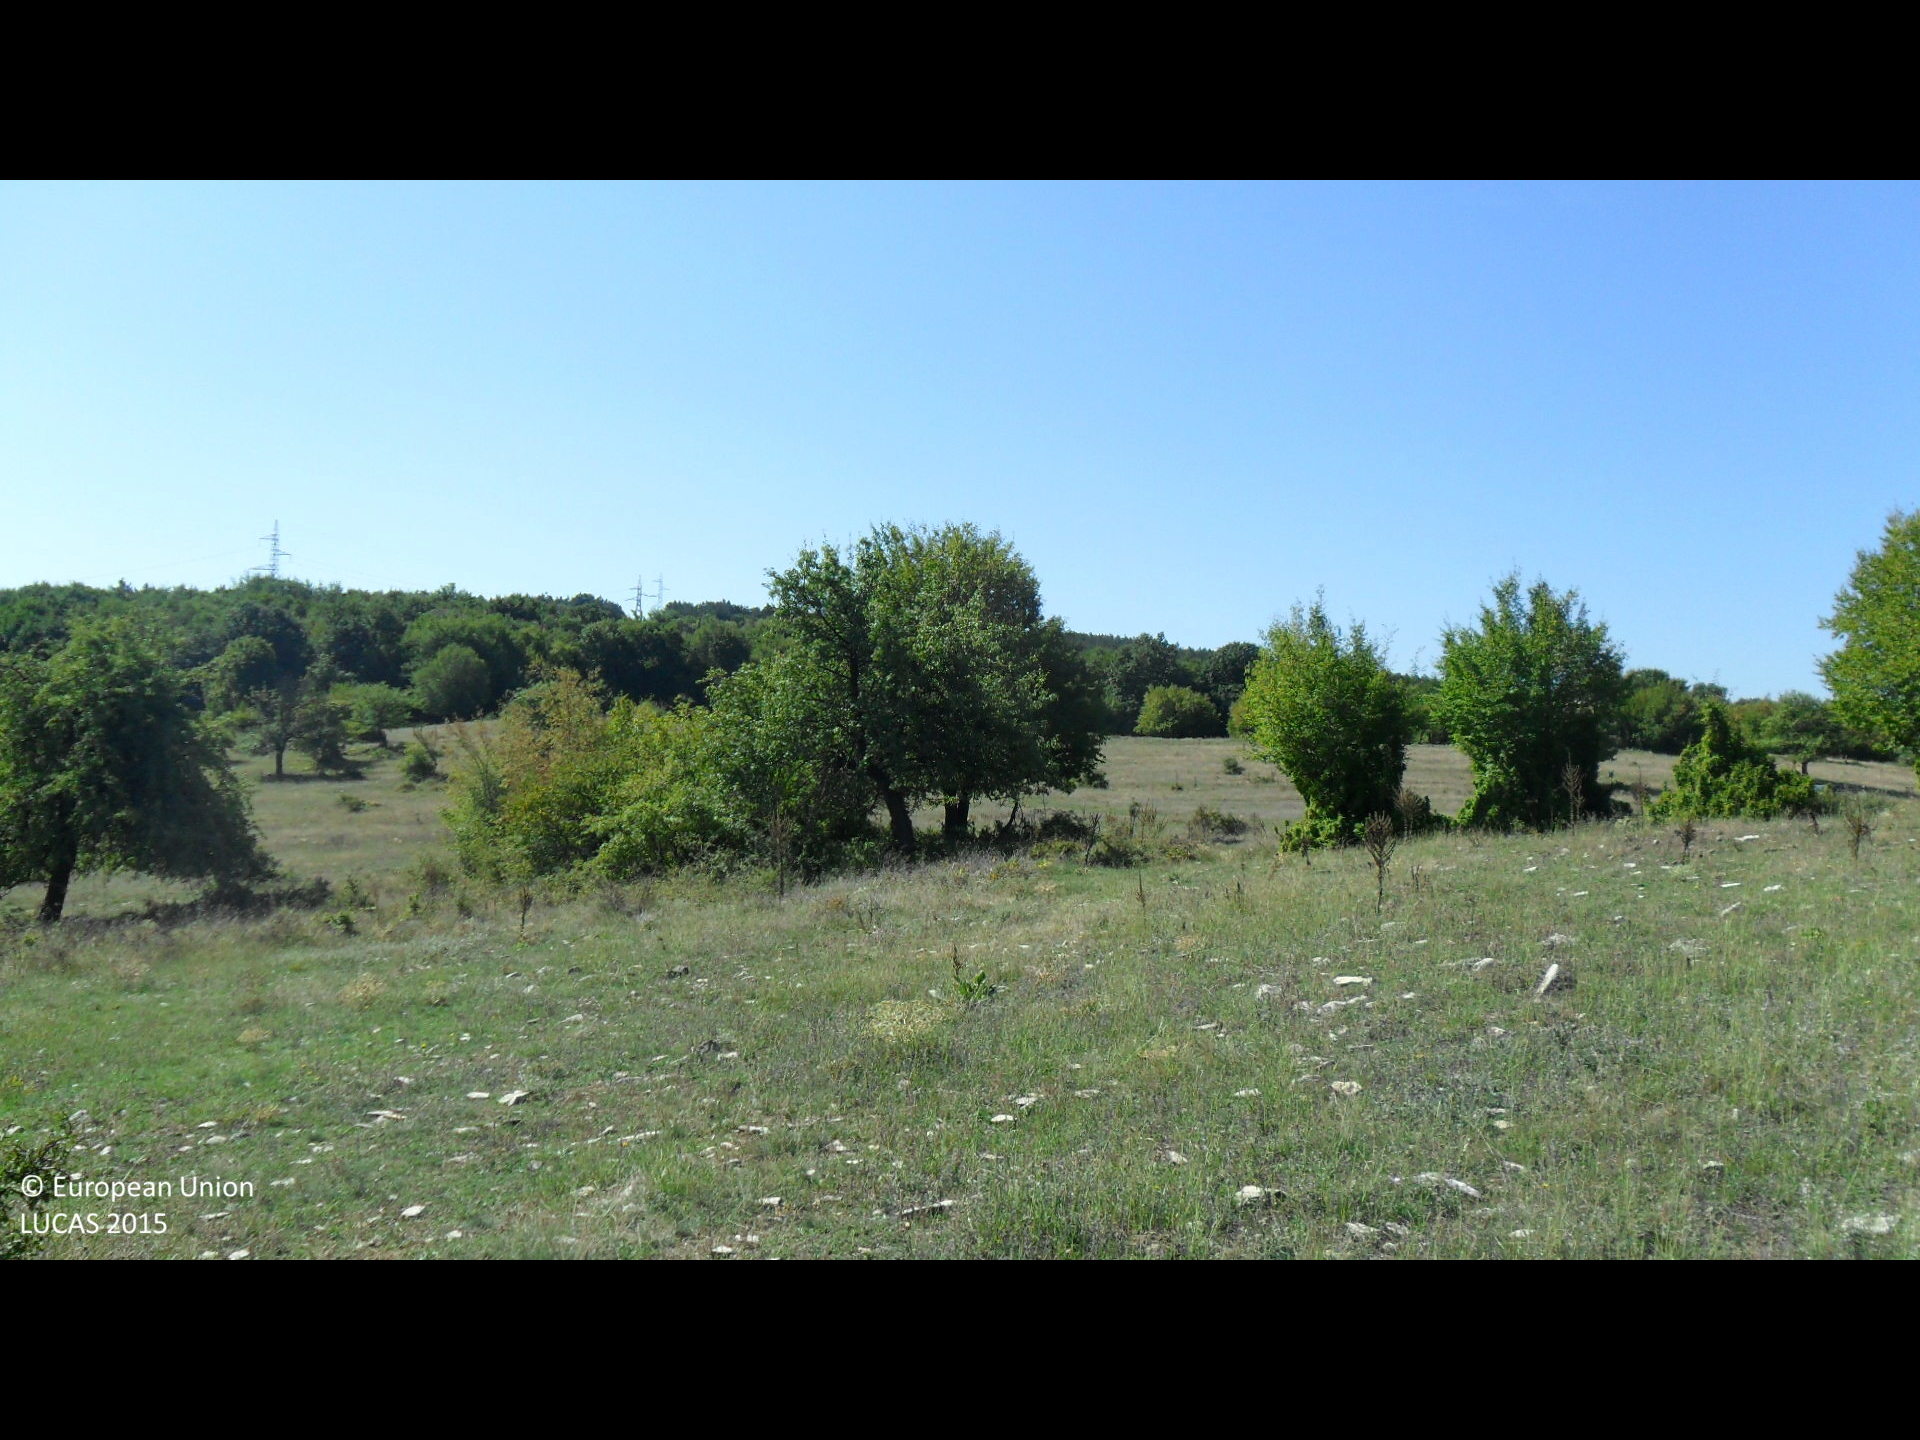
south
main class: Grassland
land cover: Grassland with sparse tree/shrub cover
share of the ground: > 75 %
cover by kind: herbaceous plants 90 %, broadleaved forest trees 5 %, shrubs 5 %
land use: Agriculture (excluding fallow land and kitchen gardens)
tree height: > 5 m
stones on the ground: 25 - 50 %
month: September
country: BG
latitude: 43.2053
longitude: 26.4824
